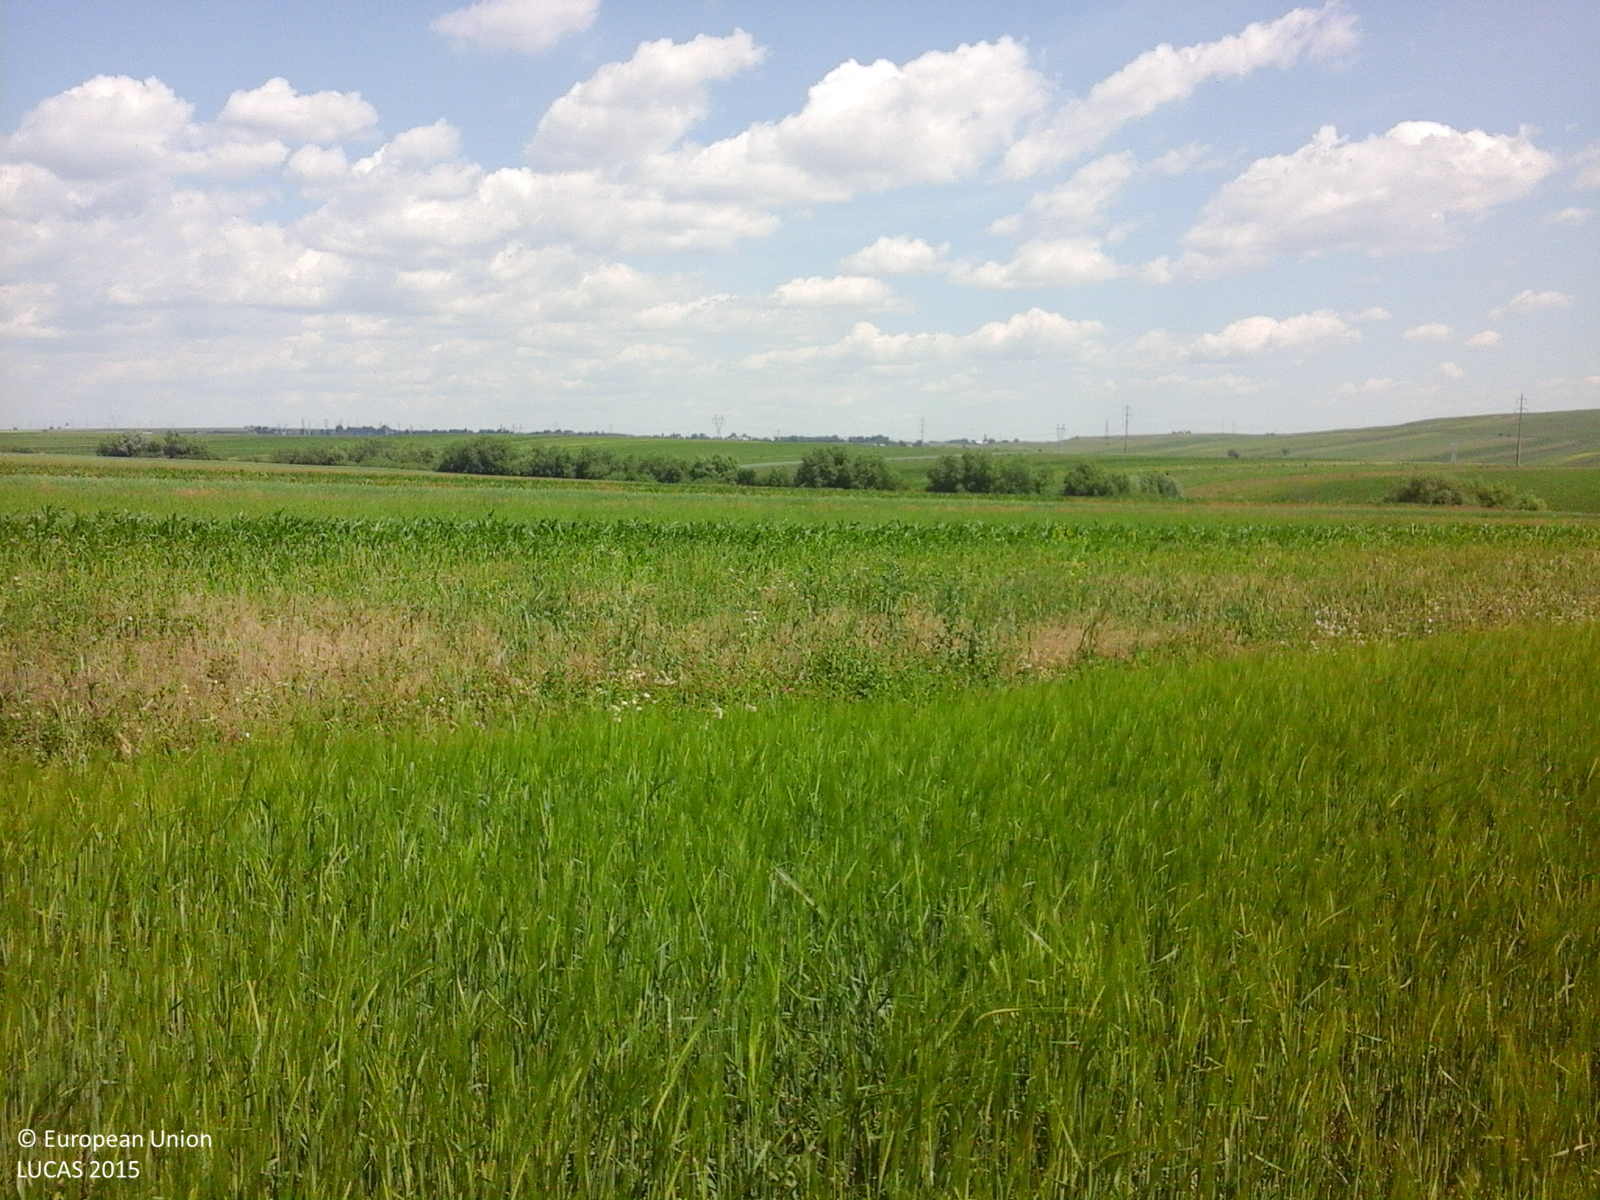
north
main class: Cropland
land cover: Barley
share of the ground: > 75 %
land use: Agriculture (excluding fallow land and kitchen gardens)
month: June
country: RO
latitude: 47.5918
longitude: 26.2672
